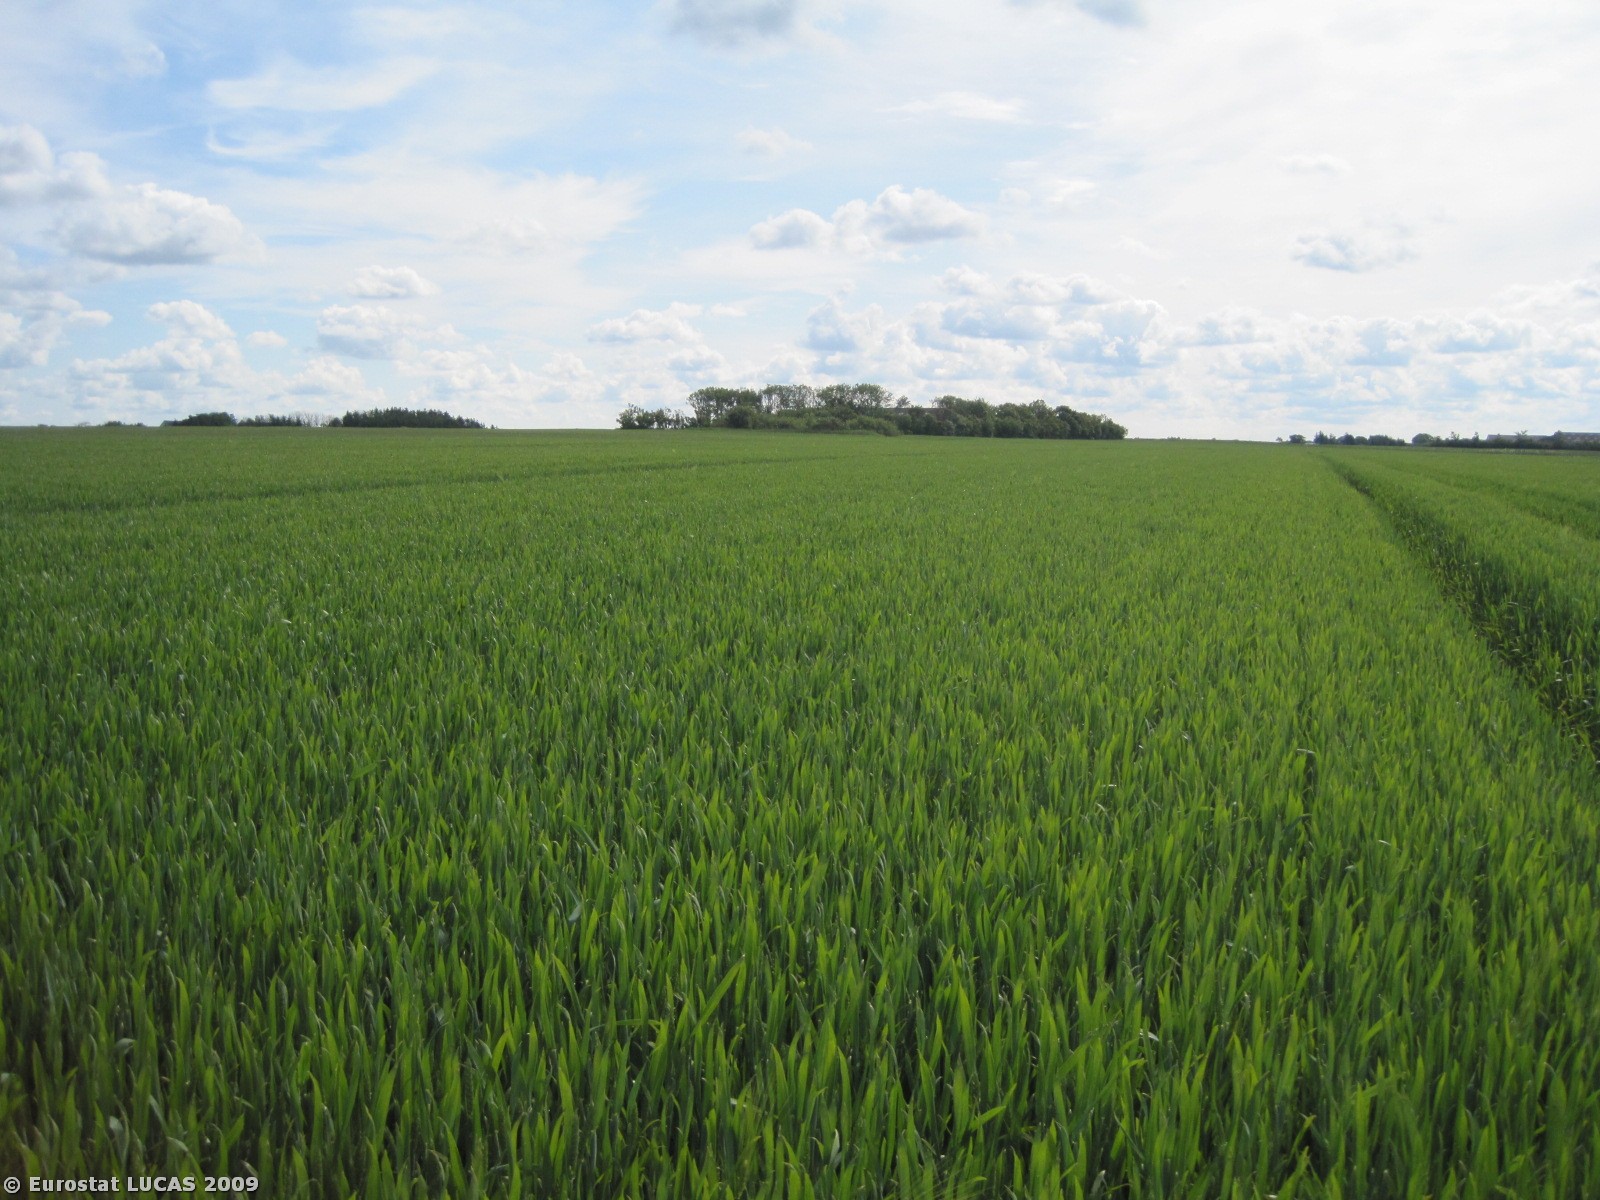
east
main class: Cropland
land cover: Common wheat
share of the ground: > 75 %
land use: Agriculture (excluding fallow land and kitchen gardens)
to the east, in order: Common wheat
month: June
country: DK
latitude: 57.4101
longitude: 9.8504
